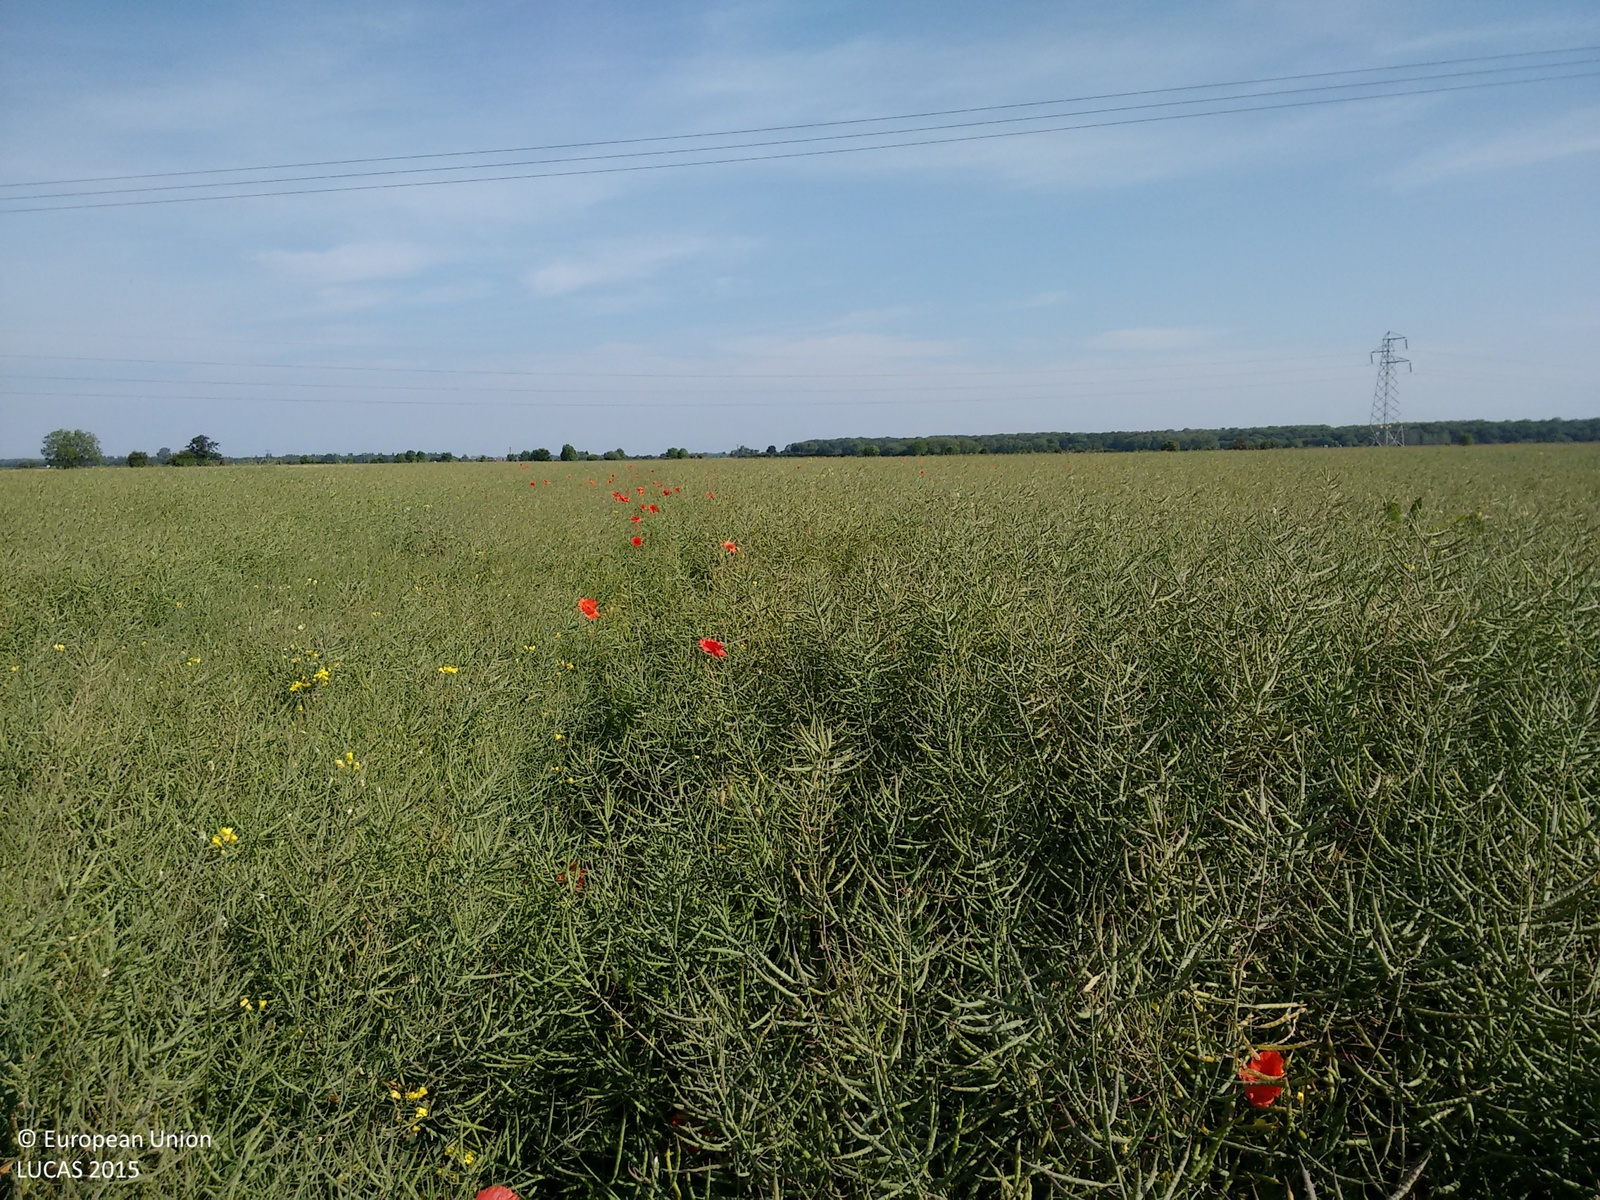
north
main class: Cropland
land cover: Rape and turnip rape
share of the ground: > 75 %
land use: Agriculture (excluding fallow land and kitchen gardens)
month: June
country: GB
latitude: 53.7733
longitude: -1.1672
